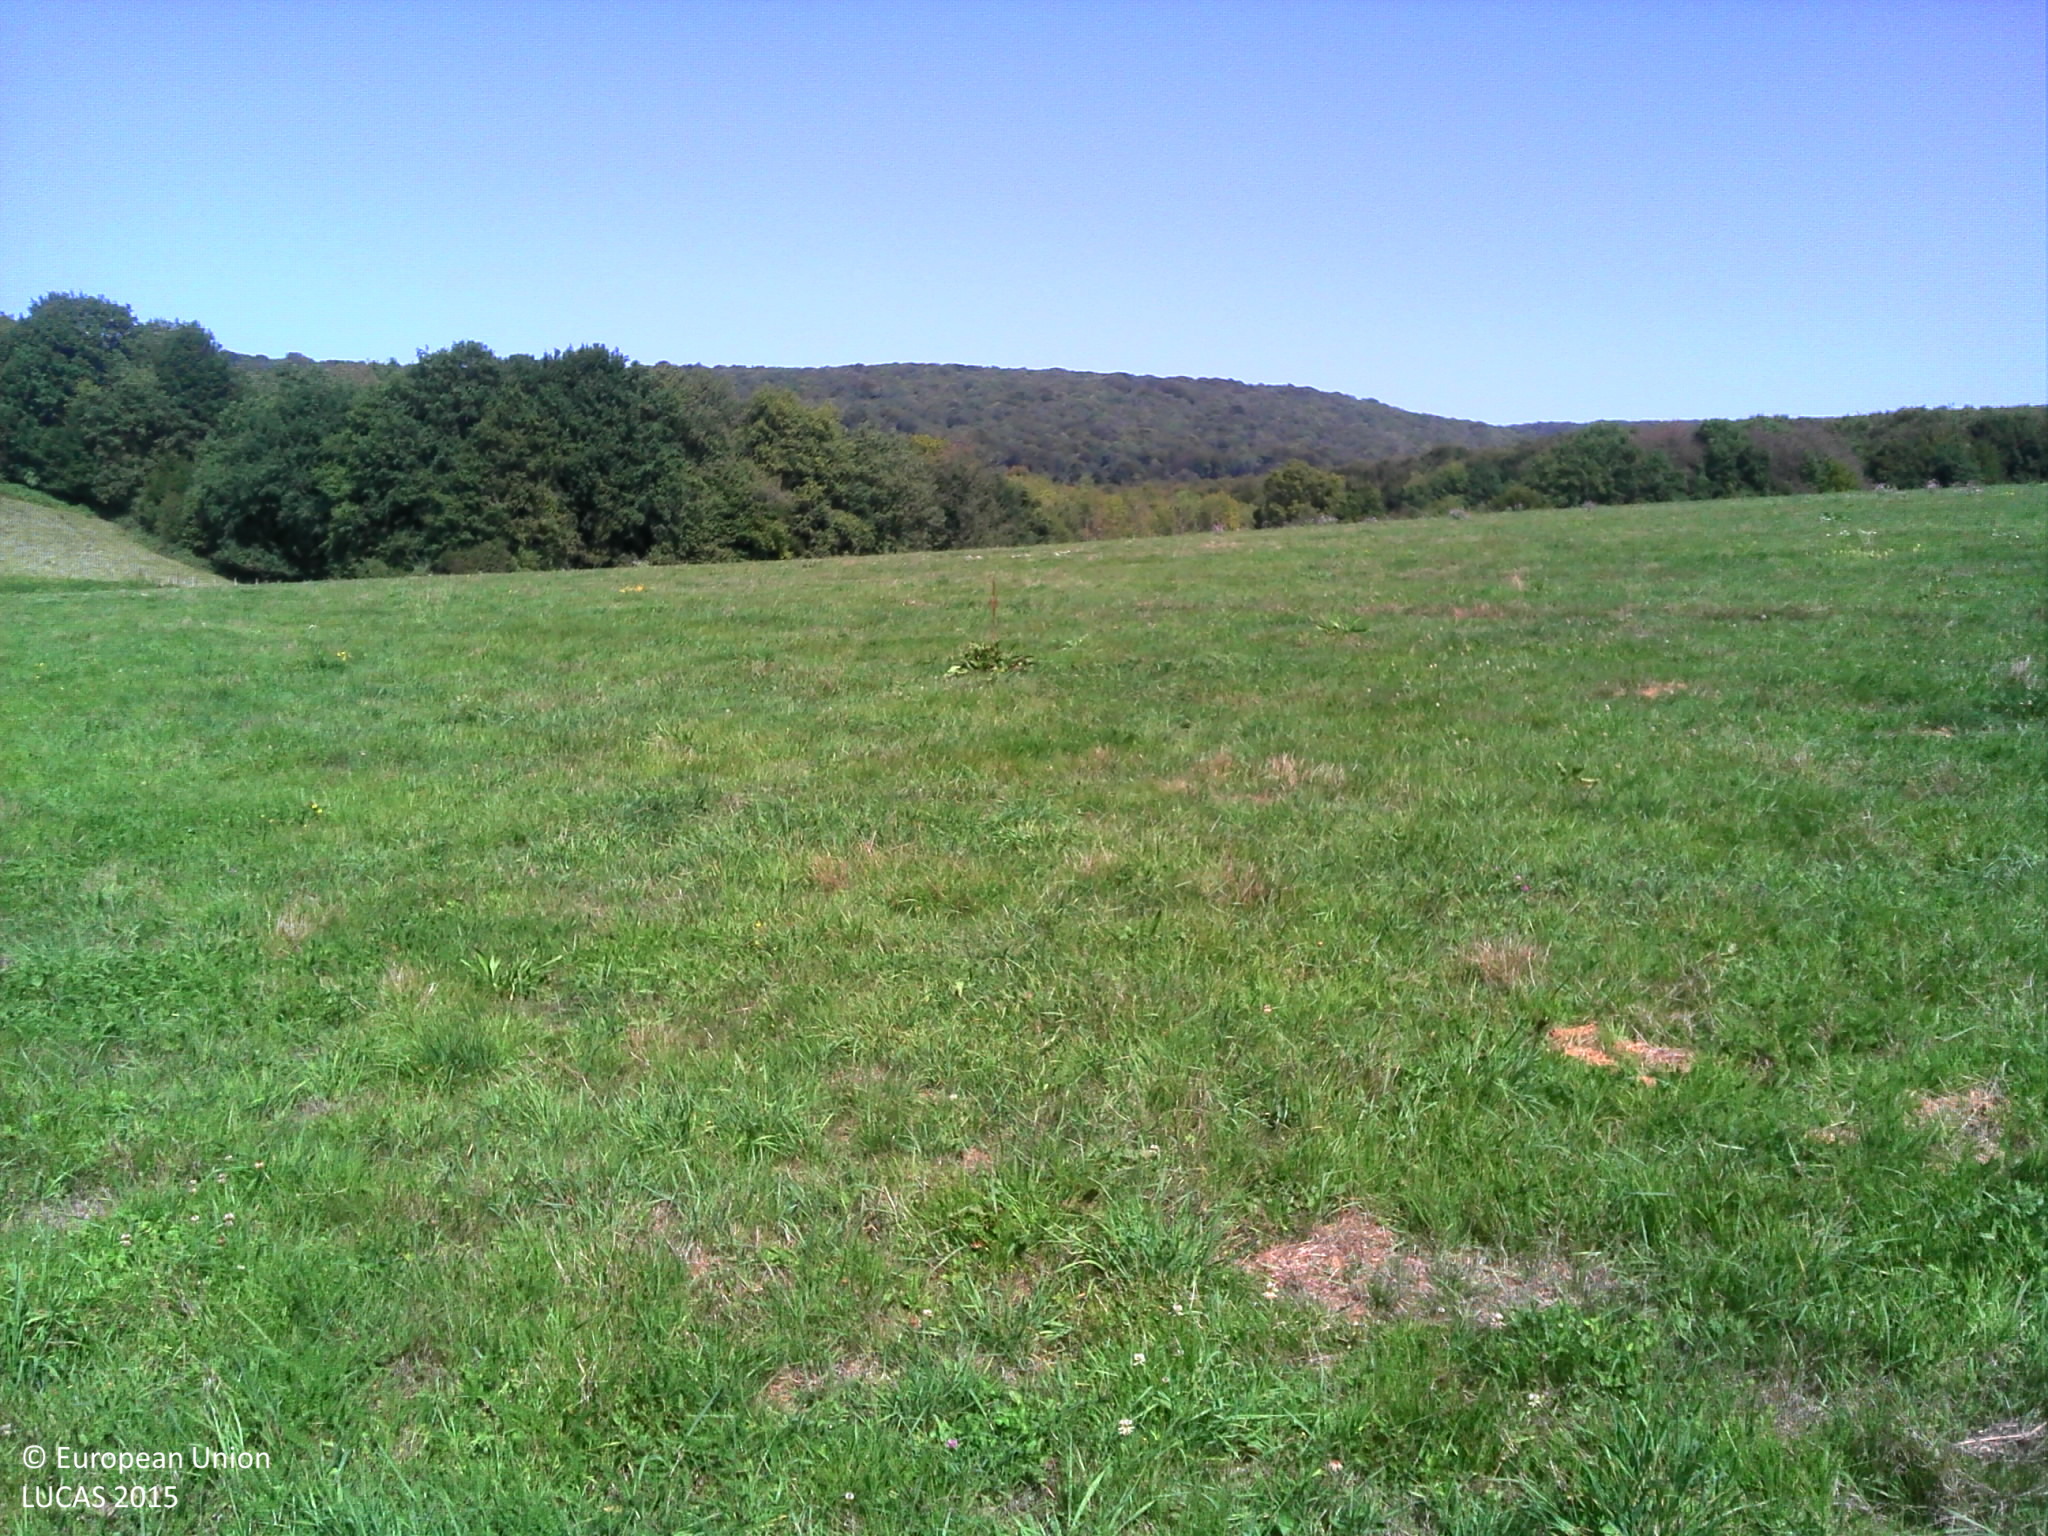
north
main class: Grassland
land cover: Grassland without tree/shrub cover
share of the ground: > 75 %
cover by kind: herbaceous plants 100 %
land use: Agriculture (excluding fallow land and kitchen gardens)
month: September
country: FR
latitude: 47.2868
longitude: 6.0219
